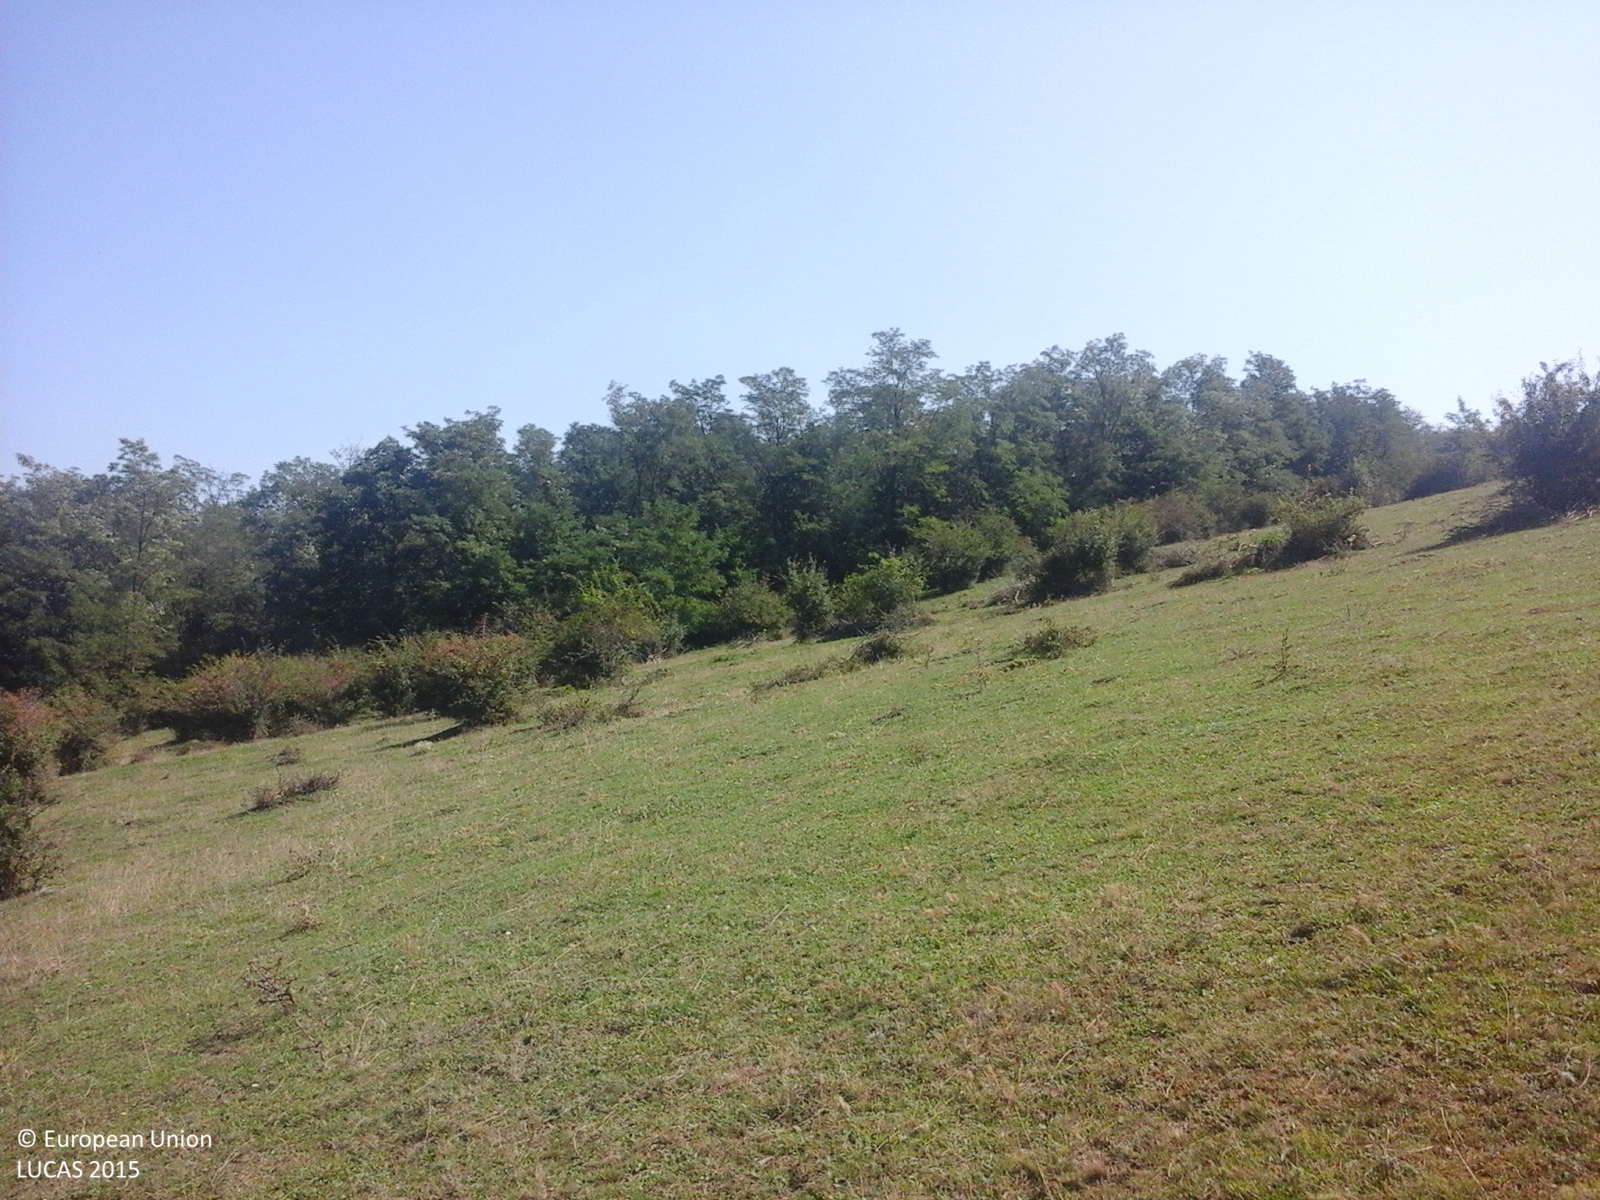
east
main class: Grassland
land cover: Grassland with sparse tree/shrub cover
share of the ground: > 75 %
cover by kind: herbaceous plants 95 %, broadleaved forest trees 5 %
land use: Fallow land
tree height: < 5 m
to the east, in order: Grassland with sparse tree/shrub cover; Broadleaved woodland
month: September
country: RO
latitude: 46.7217
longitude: 24.4129
